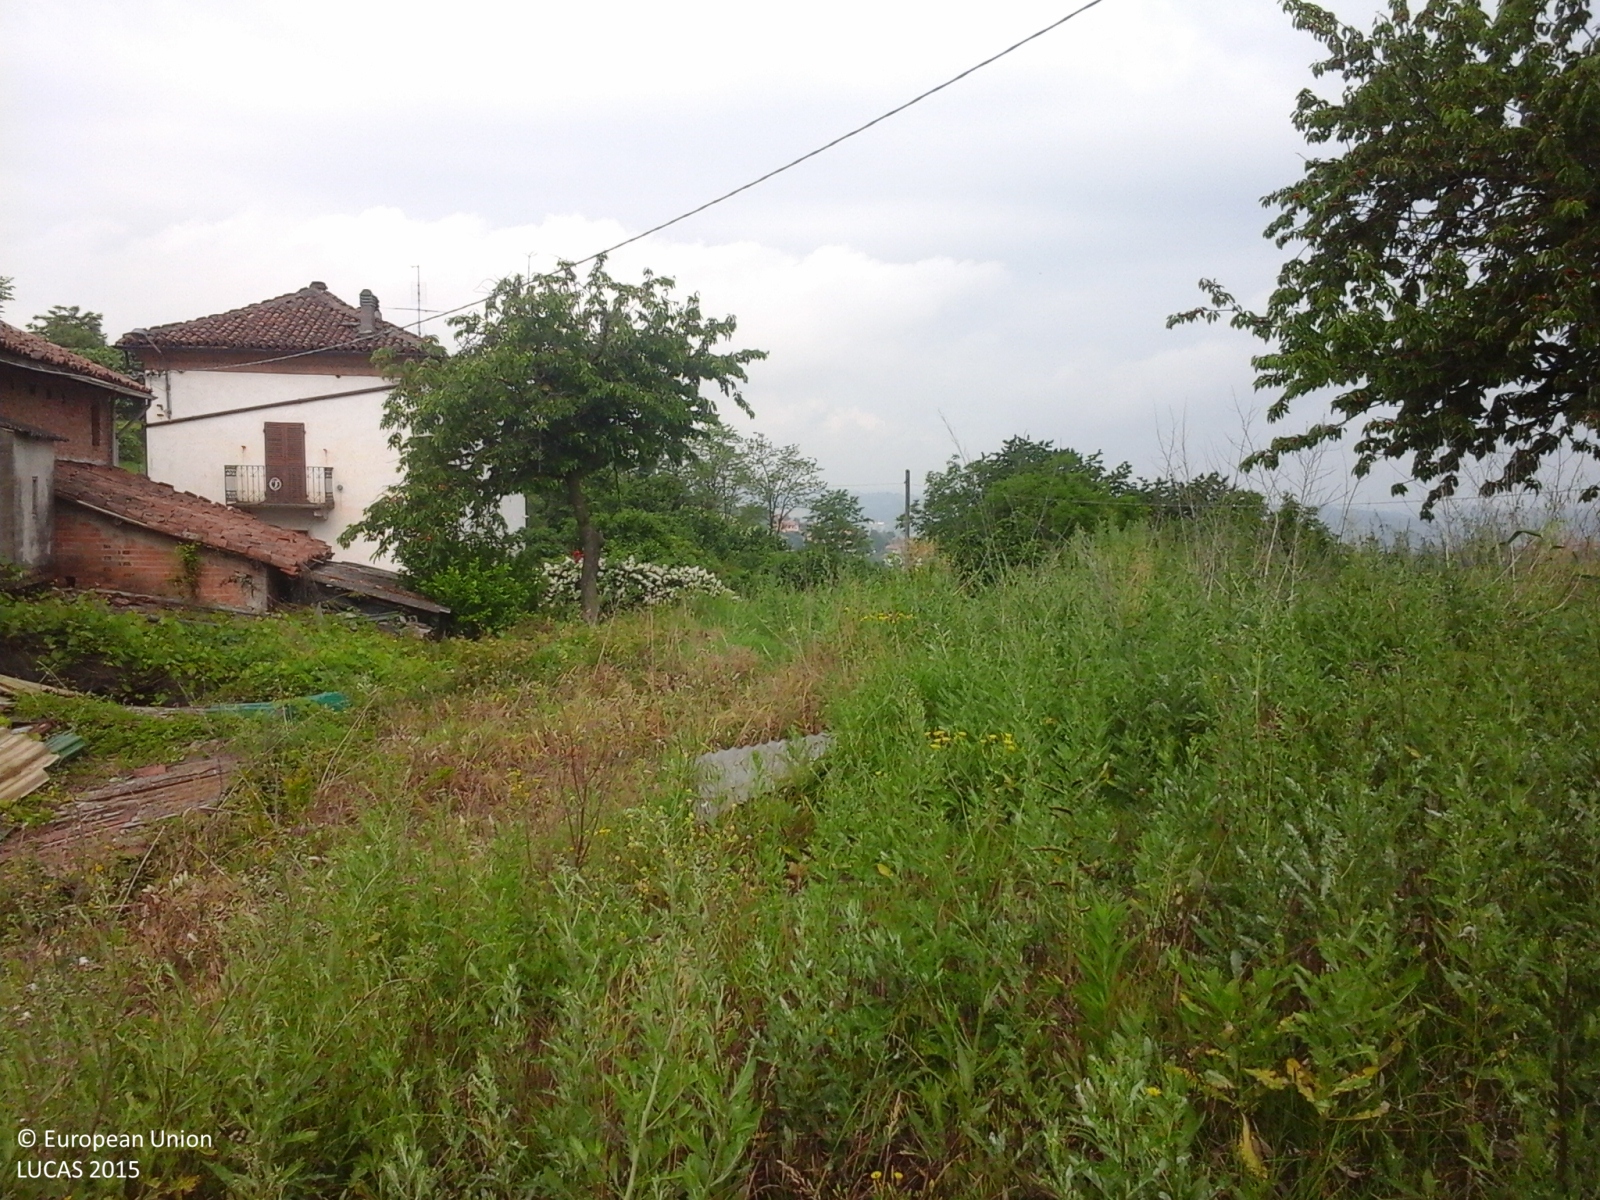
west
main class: Grassland
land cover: Spontaneously vegetated surfaces
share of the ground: > 75 %
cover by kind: herbaceous plants 100 %
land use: Fallow land
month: May
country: IT
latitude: 44.8403
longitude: 8.2197
